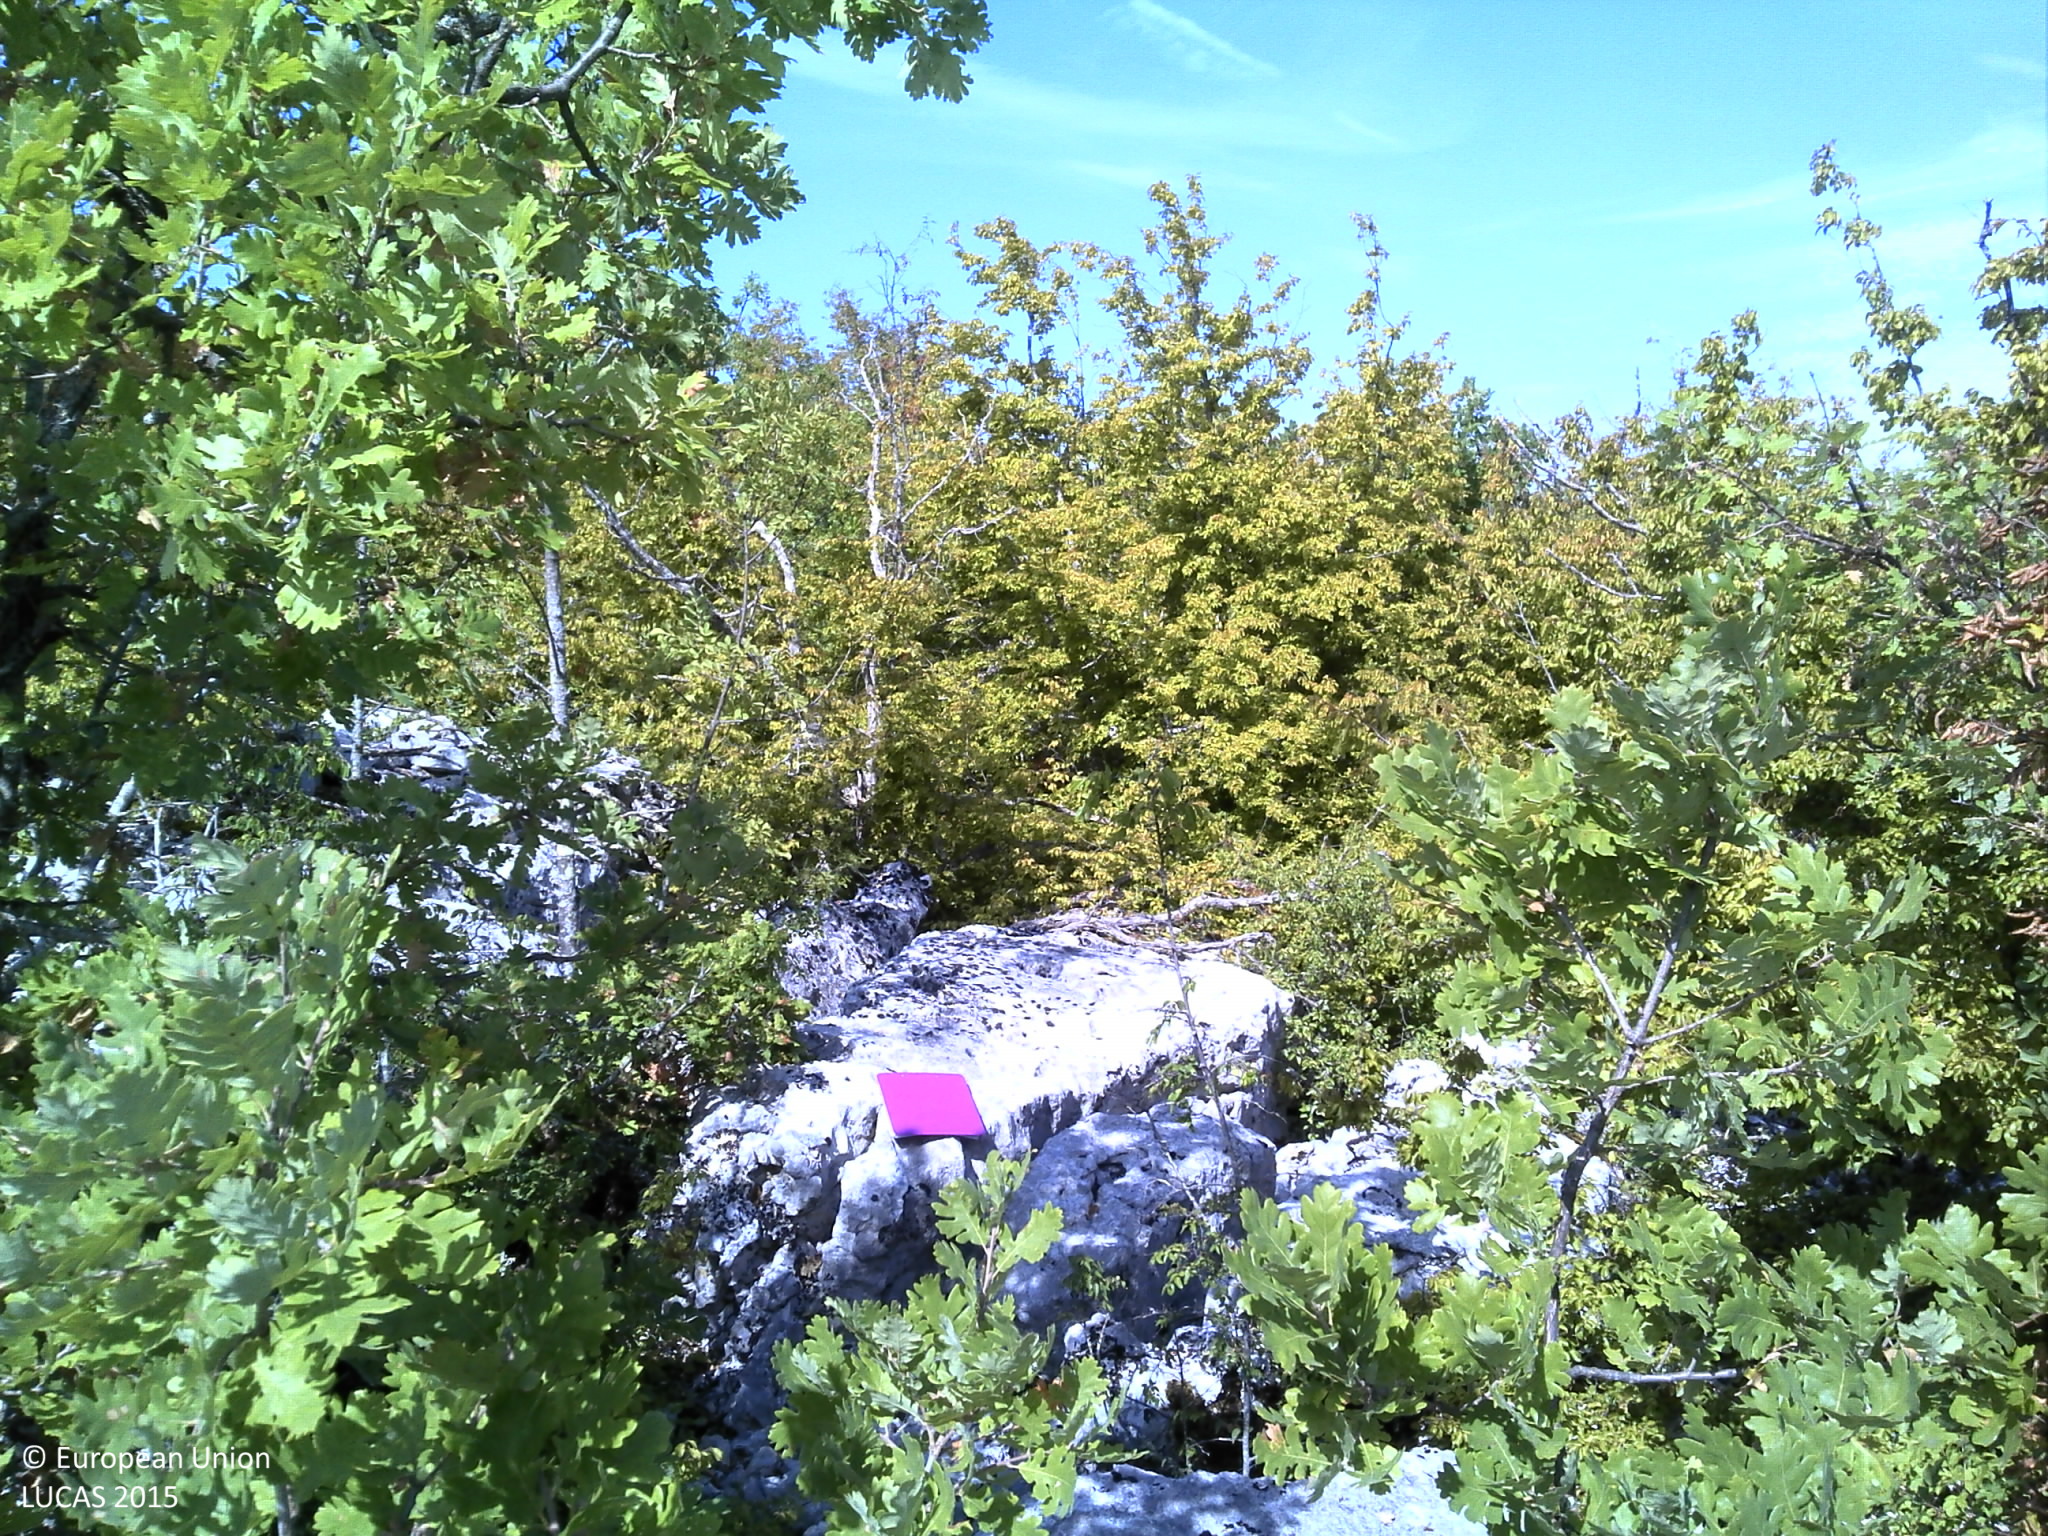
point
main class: Shrubland
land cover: Shrubland with sparse tree cover
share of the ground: > 75 %
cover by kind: shrubs 75 %, consolidated bare surface 10 %, unconsolidated bare surface 10 %, broadleaved forest trees 5 %
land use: Semi-natural and natural areas not in use
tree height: > 5 m
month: August
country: HR
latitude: 44.0038
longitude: 15.8661
